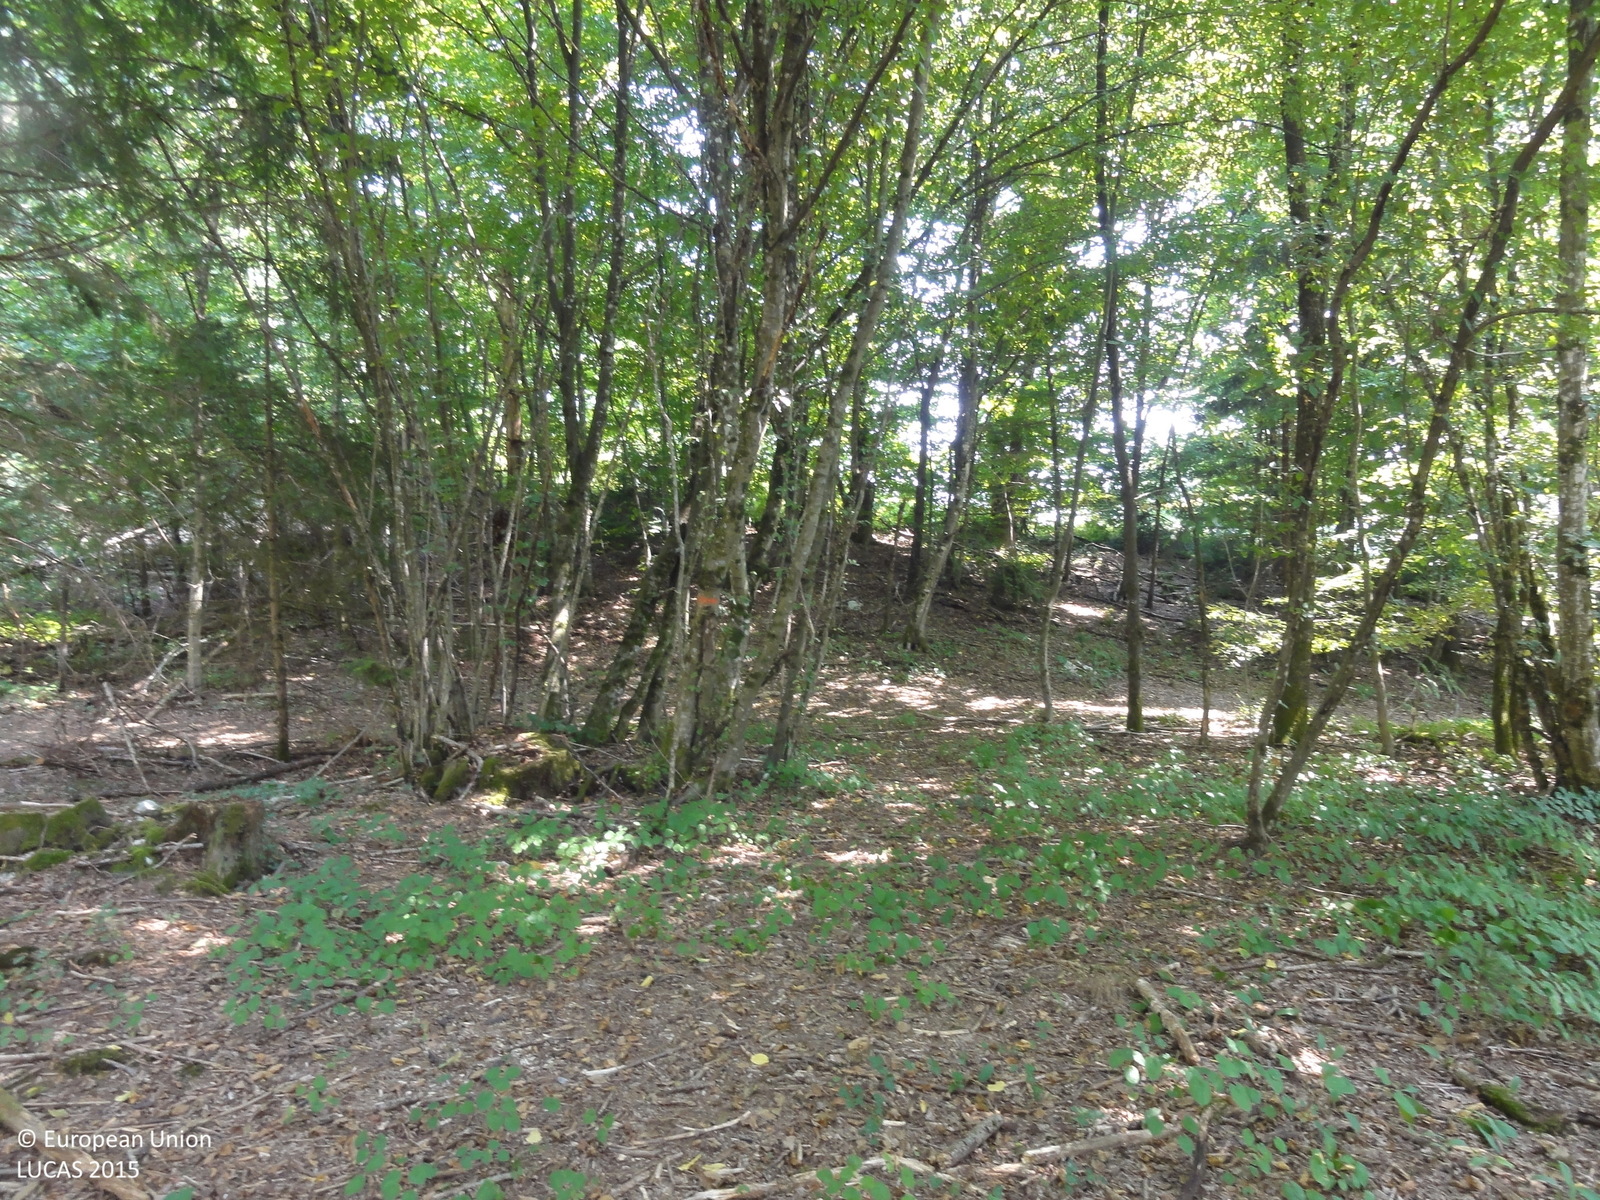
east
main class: Woodland
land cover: Spruce dominated mixed woodland
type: mountainous beech forest
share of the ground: > 75 %
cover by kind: broadleaved forest trees 65 %, coniferous forest trees 35 %
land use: Forestry
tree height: > 5 m
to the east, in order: Spruce dominated mixed woodland; Tracks; Spruce dominated mixed woodland; Shrubland without tree cover; Grassland without tree/shrub cover; Grassland with sparse tree/shrub cover; Spruce dominated mixed woodland; Grass margins; Tracks; Fences; Maize
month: August
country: SI
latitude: 45.7782
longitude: 15.1023
